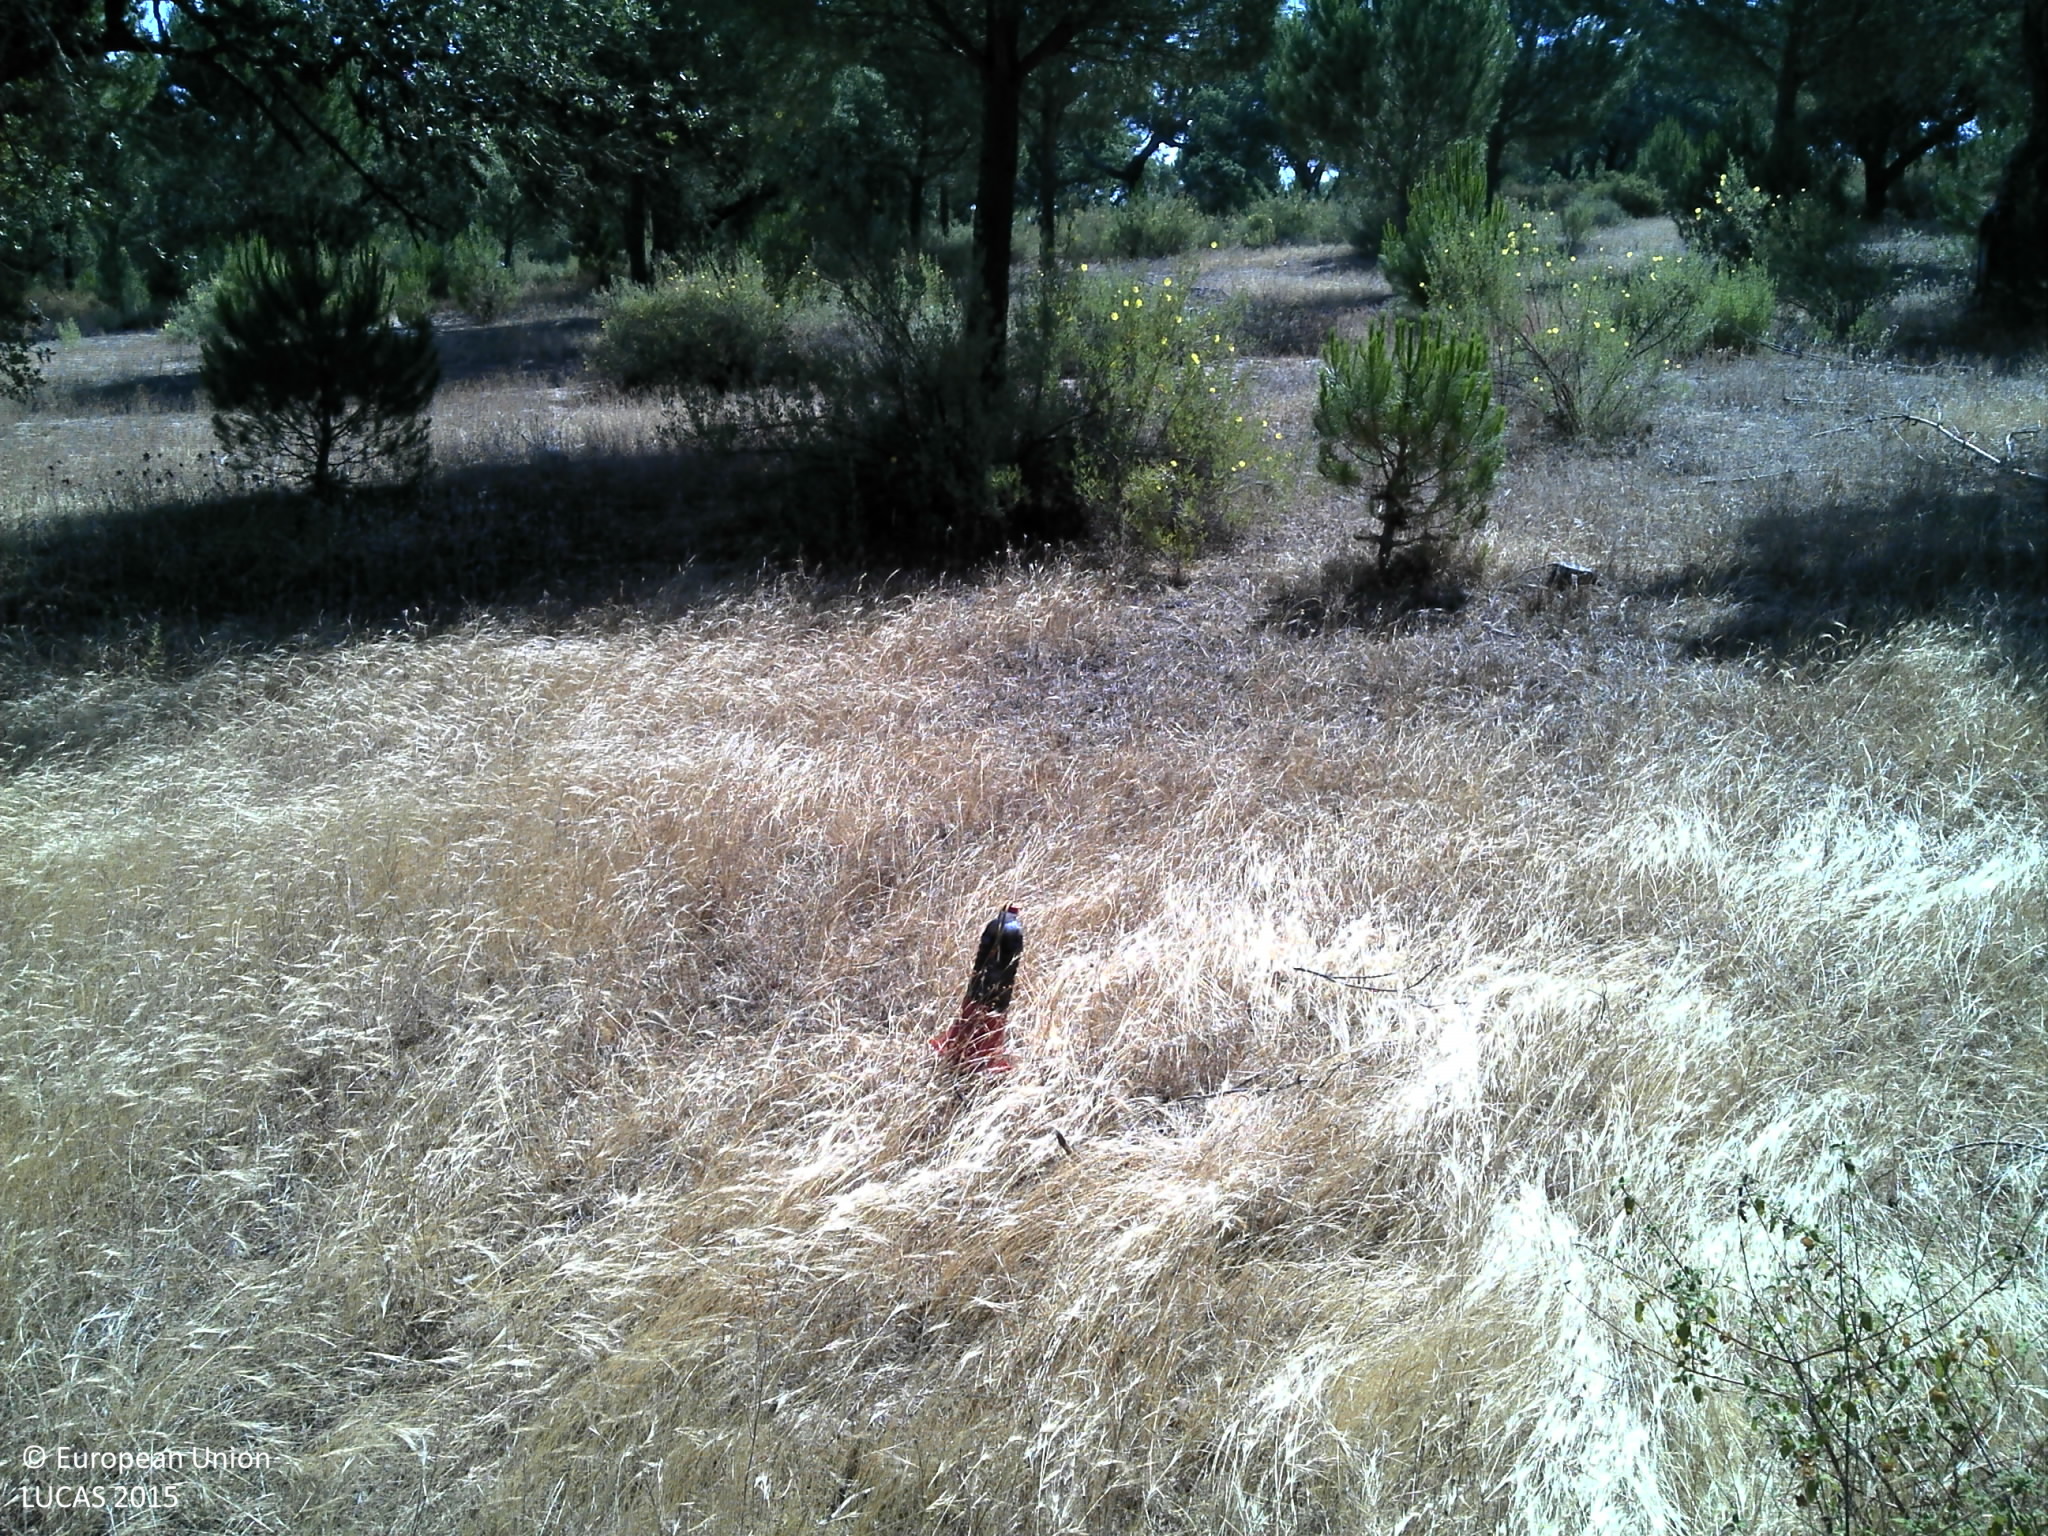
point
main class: Woodland
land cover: Pine dominated coniferous woodland
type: coniferous forest of the mediterranean region
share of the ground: 25 - 50 %
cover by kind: unconsolidated bare surface 50 %, coniferous forest trees 25 %, herbaceous plants 25 %
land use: Forestry
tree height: > 5 m
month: June
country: PT
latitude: 38.1131
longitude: -8.3473
